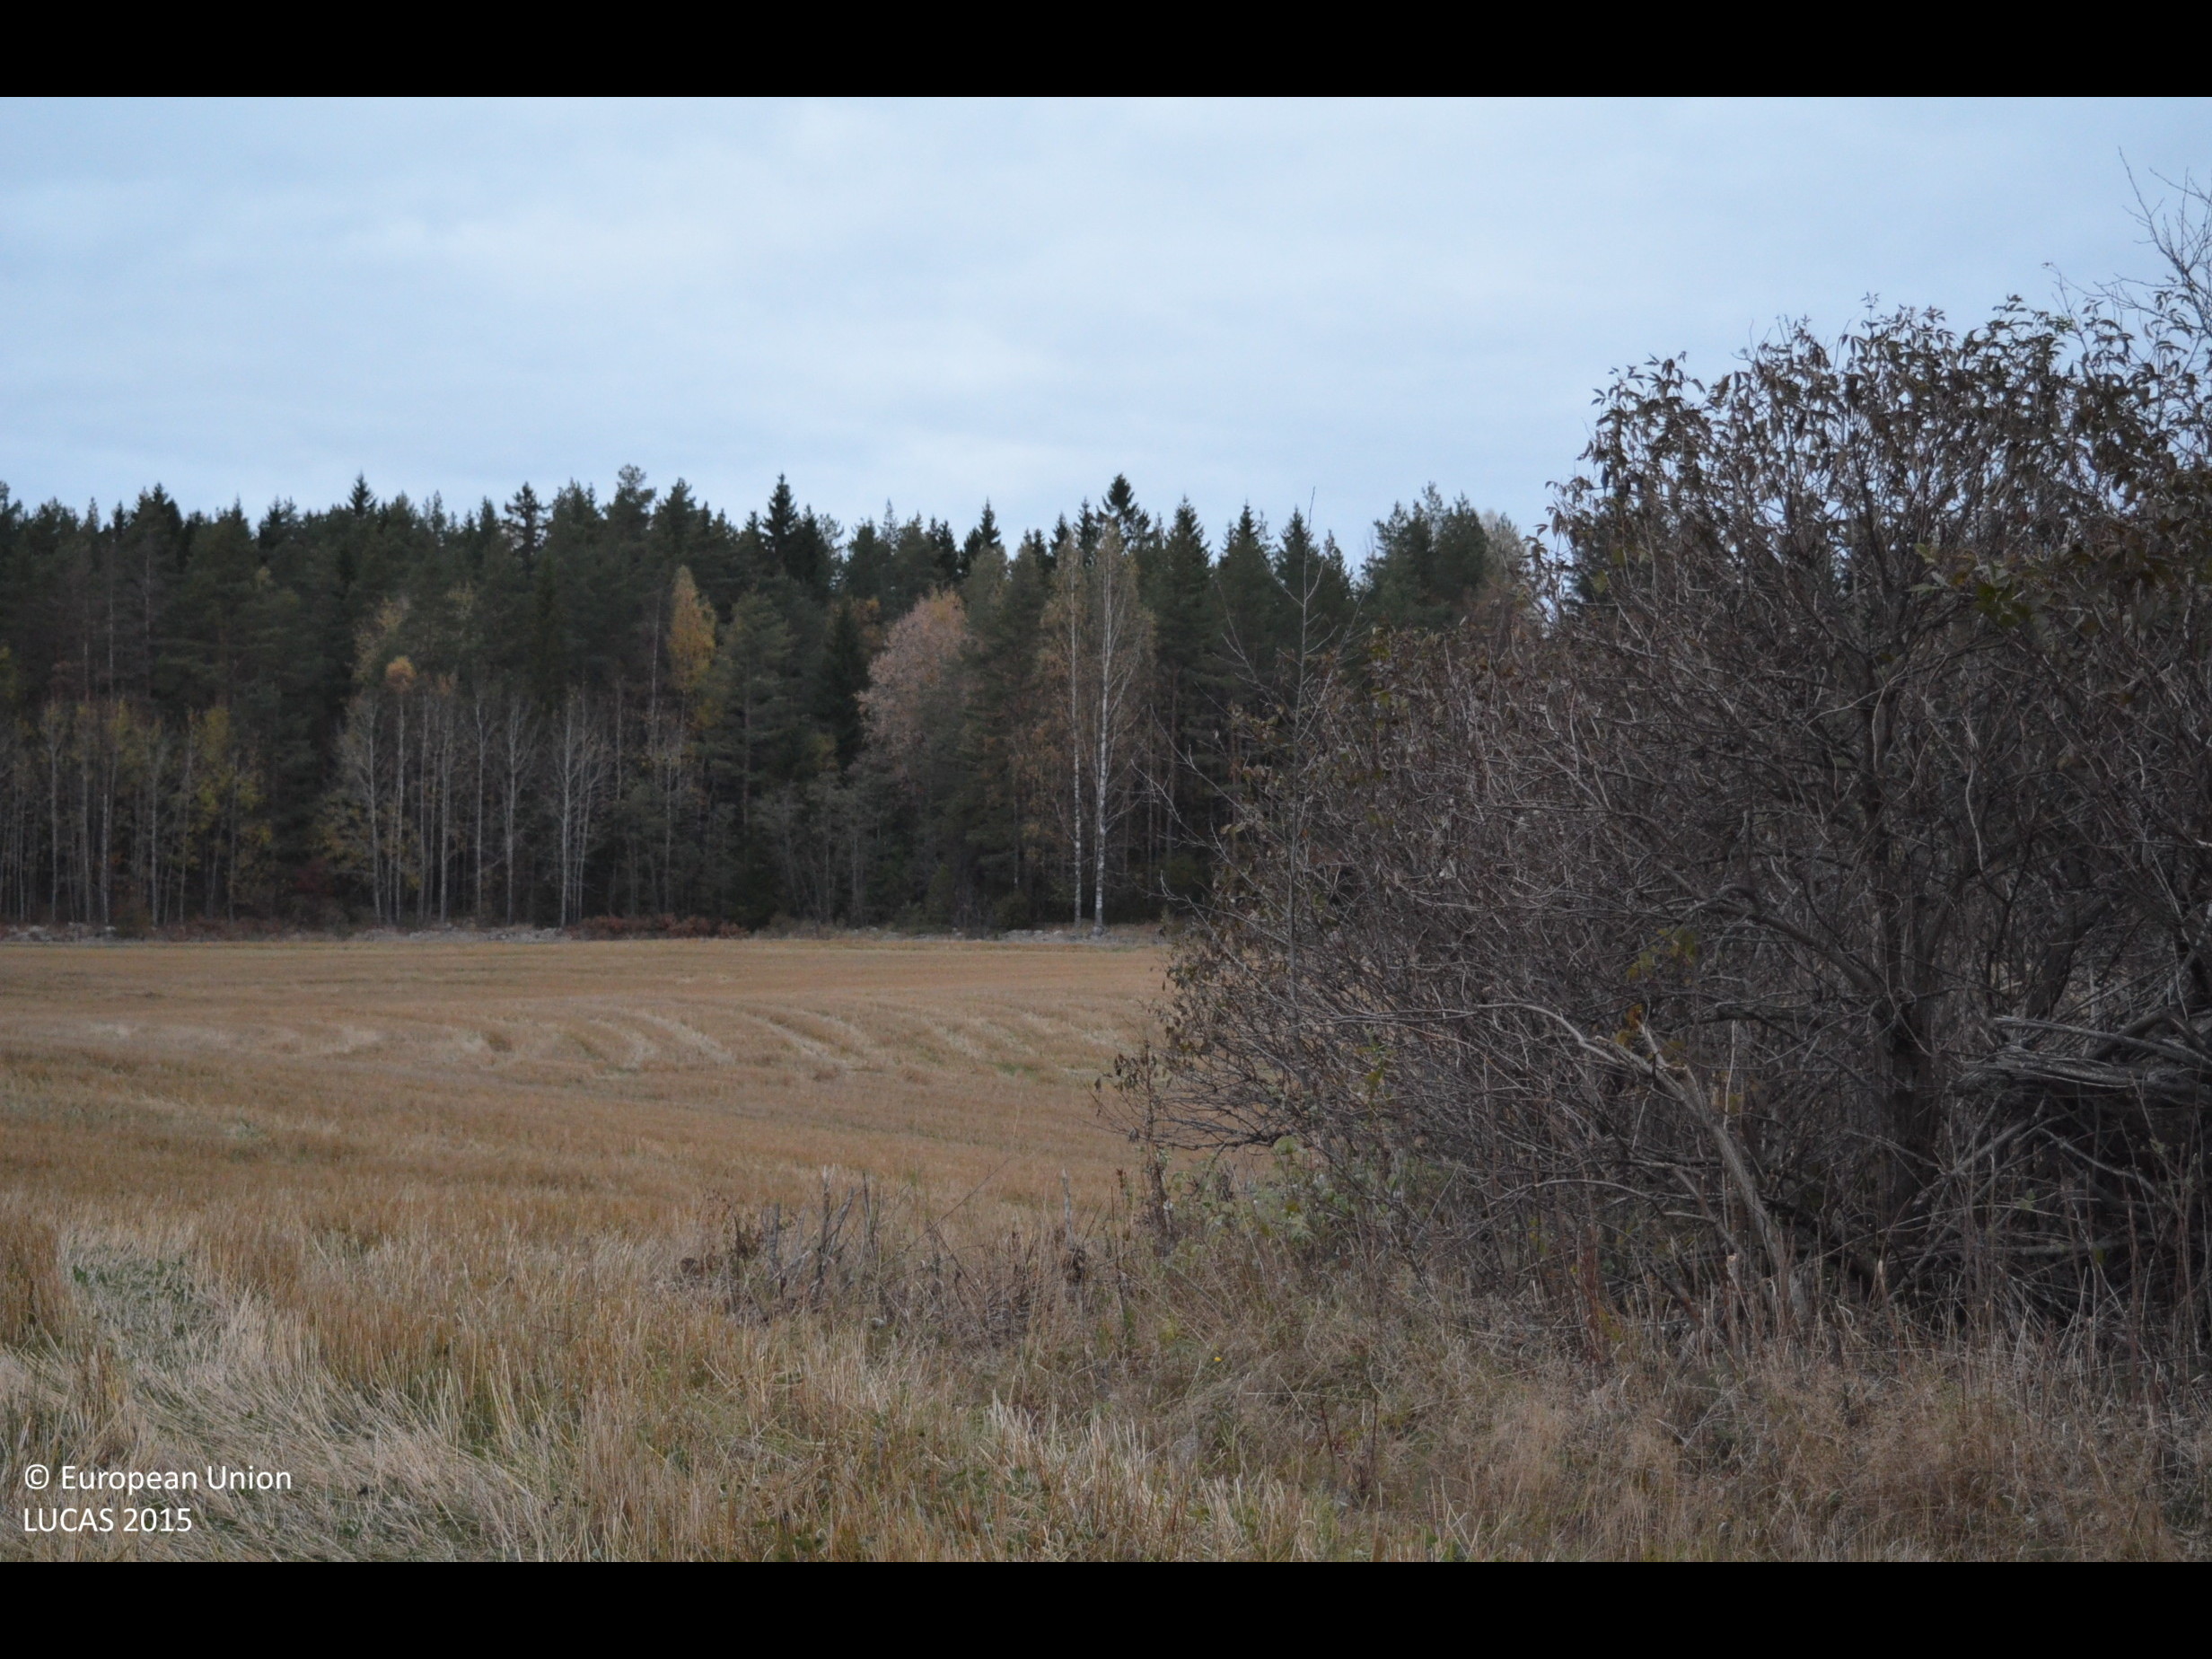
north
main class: Cropland
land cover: Oats
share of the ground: > 75 %
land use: Agriculture (excluding fallow land and kitchen gardens)
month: October
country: FI
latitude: 61.6773
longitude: 23.8199
